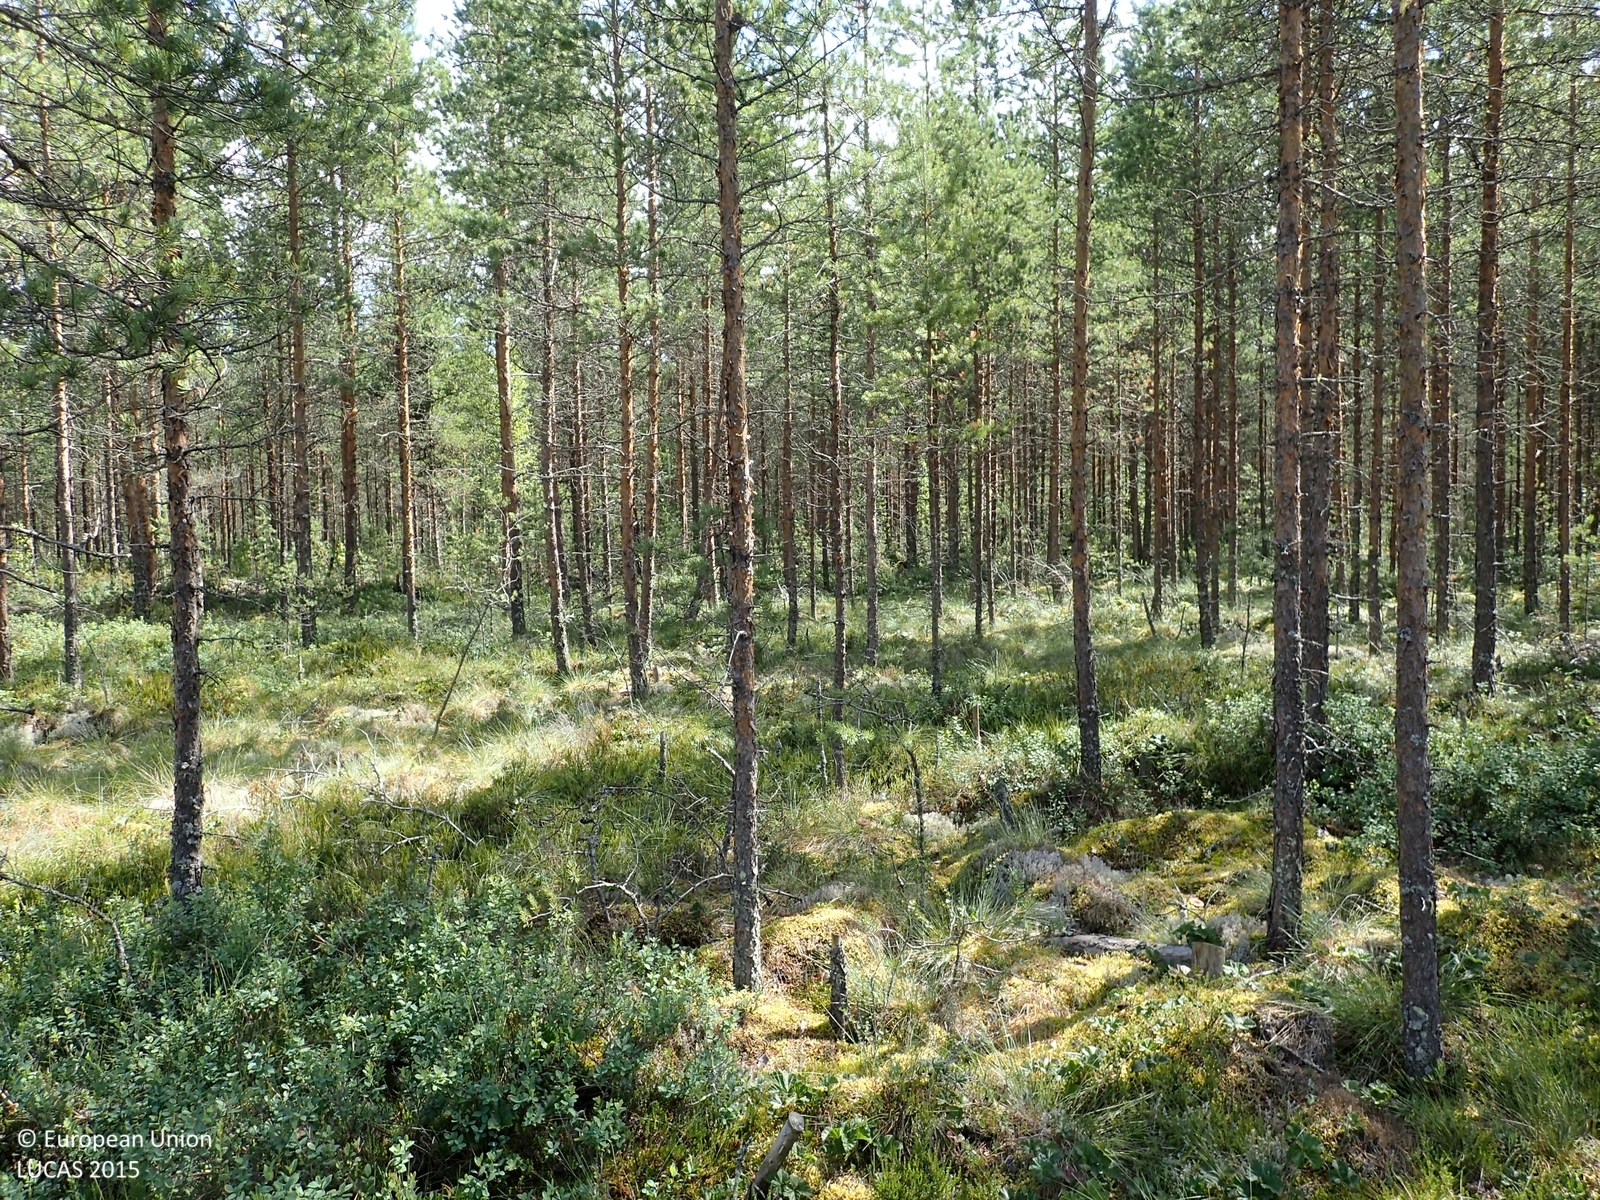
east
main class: Woodland
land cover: Pine dominated coniferous woodland
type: mire and swamp forests
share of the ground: 50 - 75 %
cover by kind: coniferous forest trees 60 %, shrubs 30 %, herbaceous plants 5 %, lichens and mosses 5 %
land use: Forestry
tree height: < 5 m
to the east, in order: Pine dominated coniferous woodland; Ditches and canals; Pine dominated coniferous woodland; Ditches and canals; Pine dominated coniferous woodland; Ditches and canals; Pine dominated coniferous woodland; Ditches and canals; Pine dominated mixed woodland
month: July
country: FI
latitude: 62.8987
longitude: 22.6668
